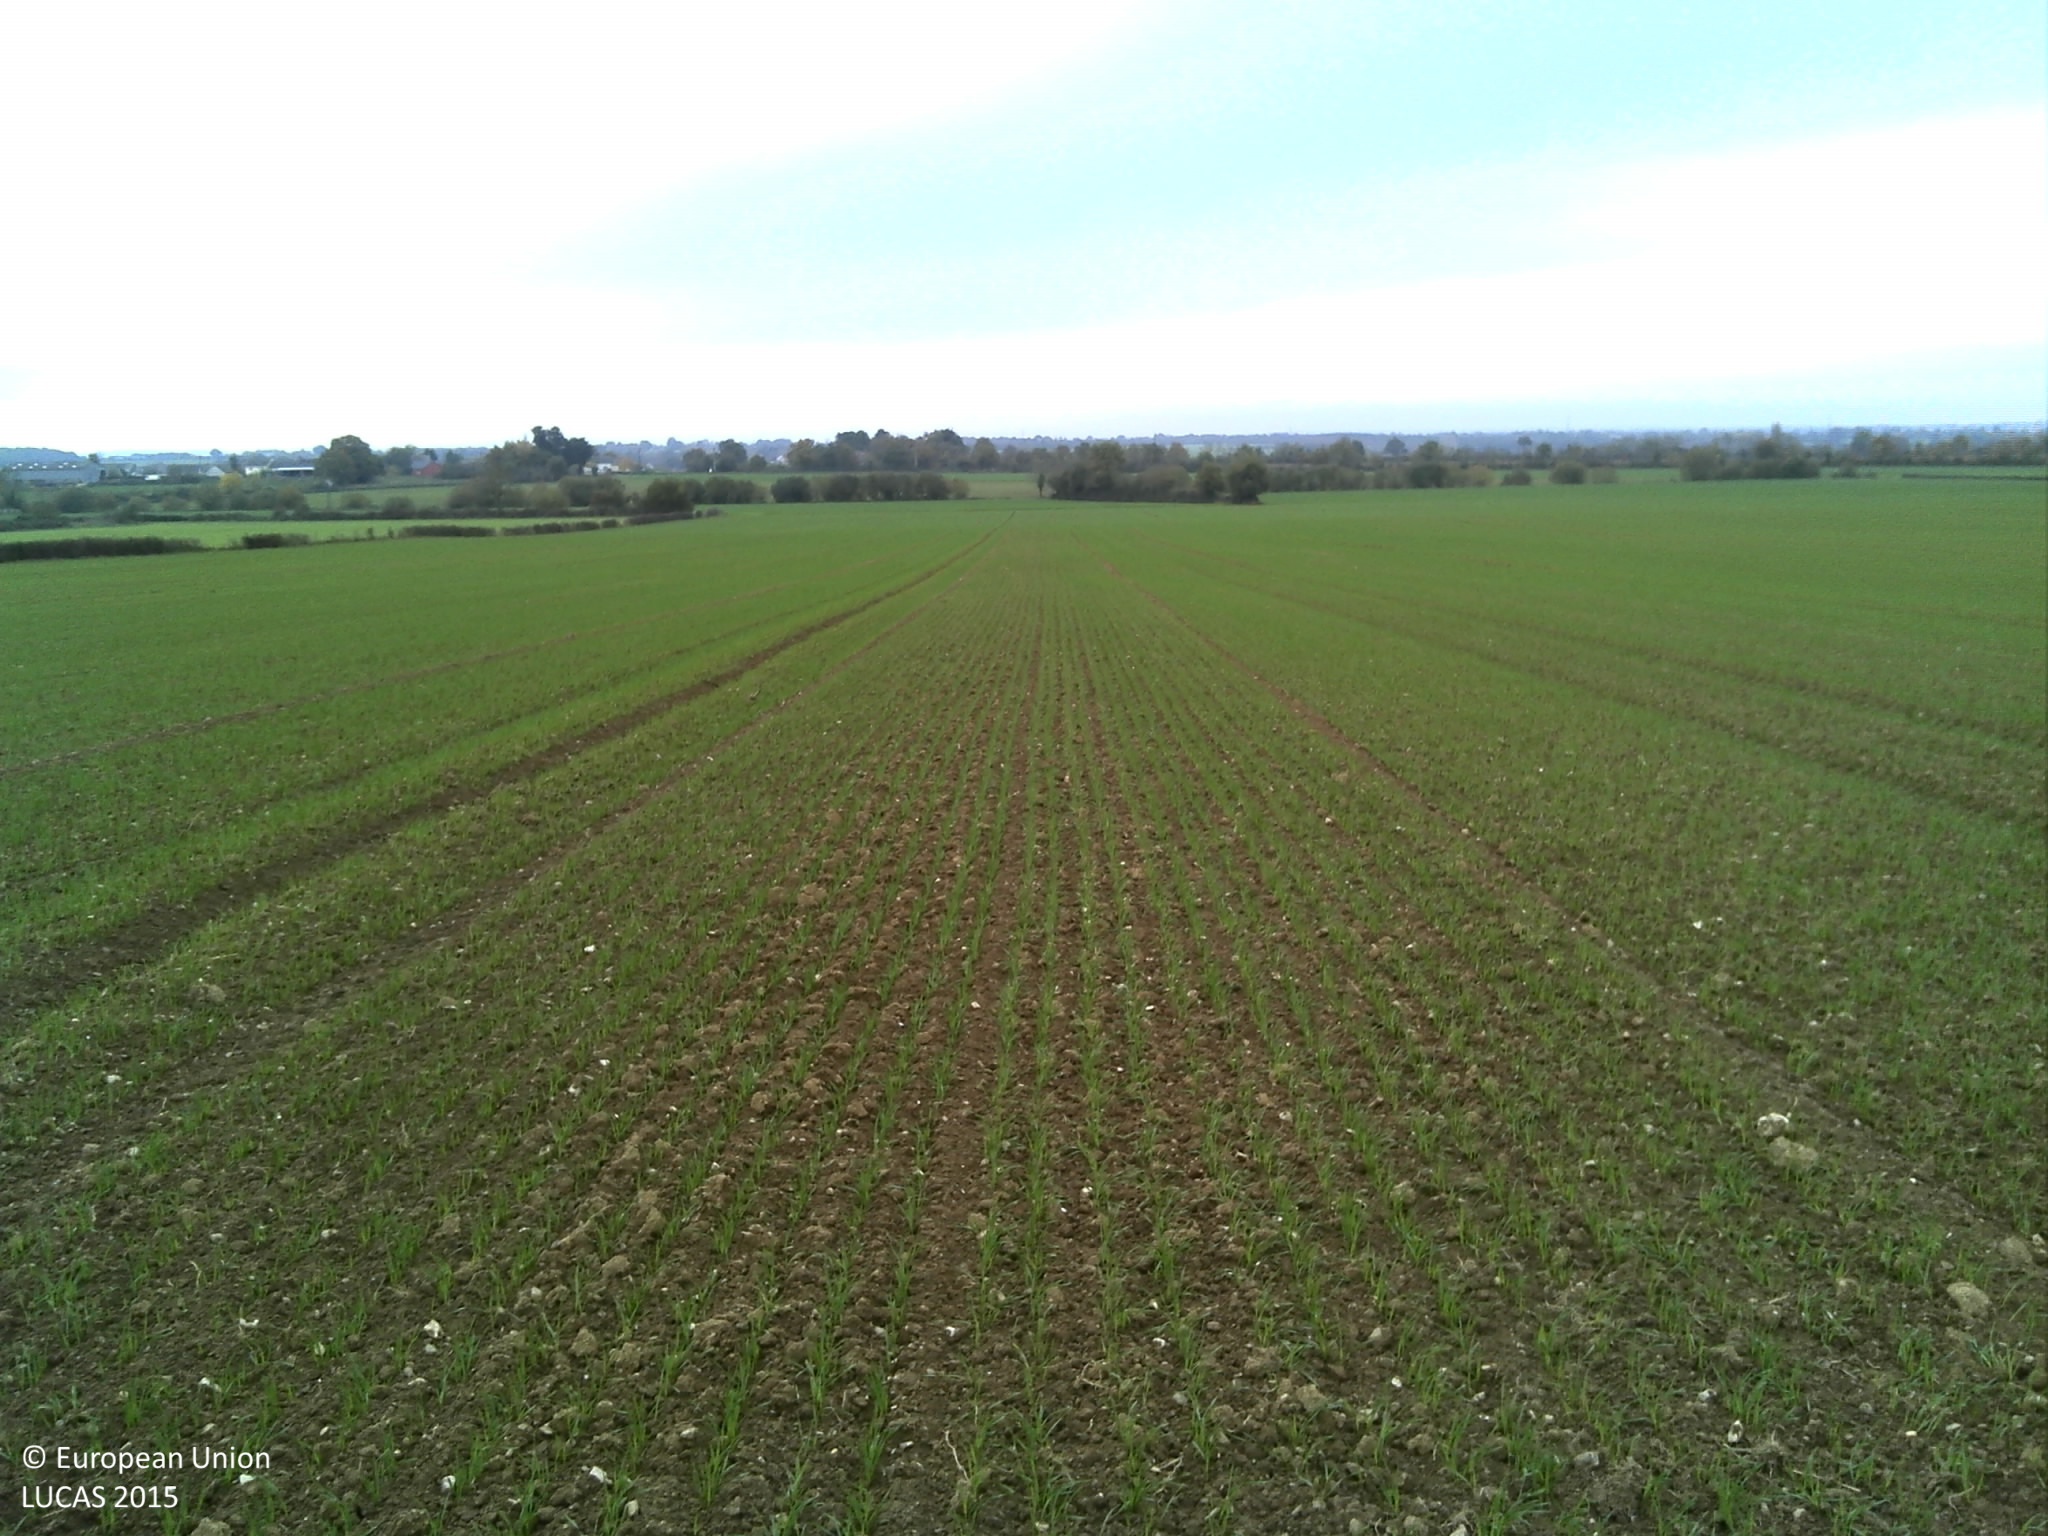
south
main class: Cropland
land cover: Common wheat
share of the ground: < 10 %
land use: Agriculture (excluding fallow land and kitchen gardens)
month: November
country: FR
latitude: 47.4559
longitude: -1.3282
